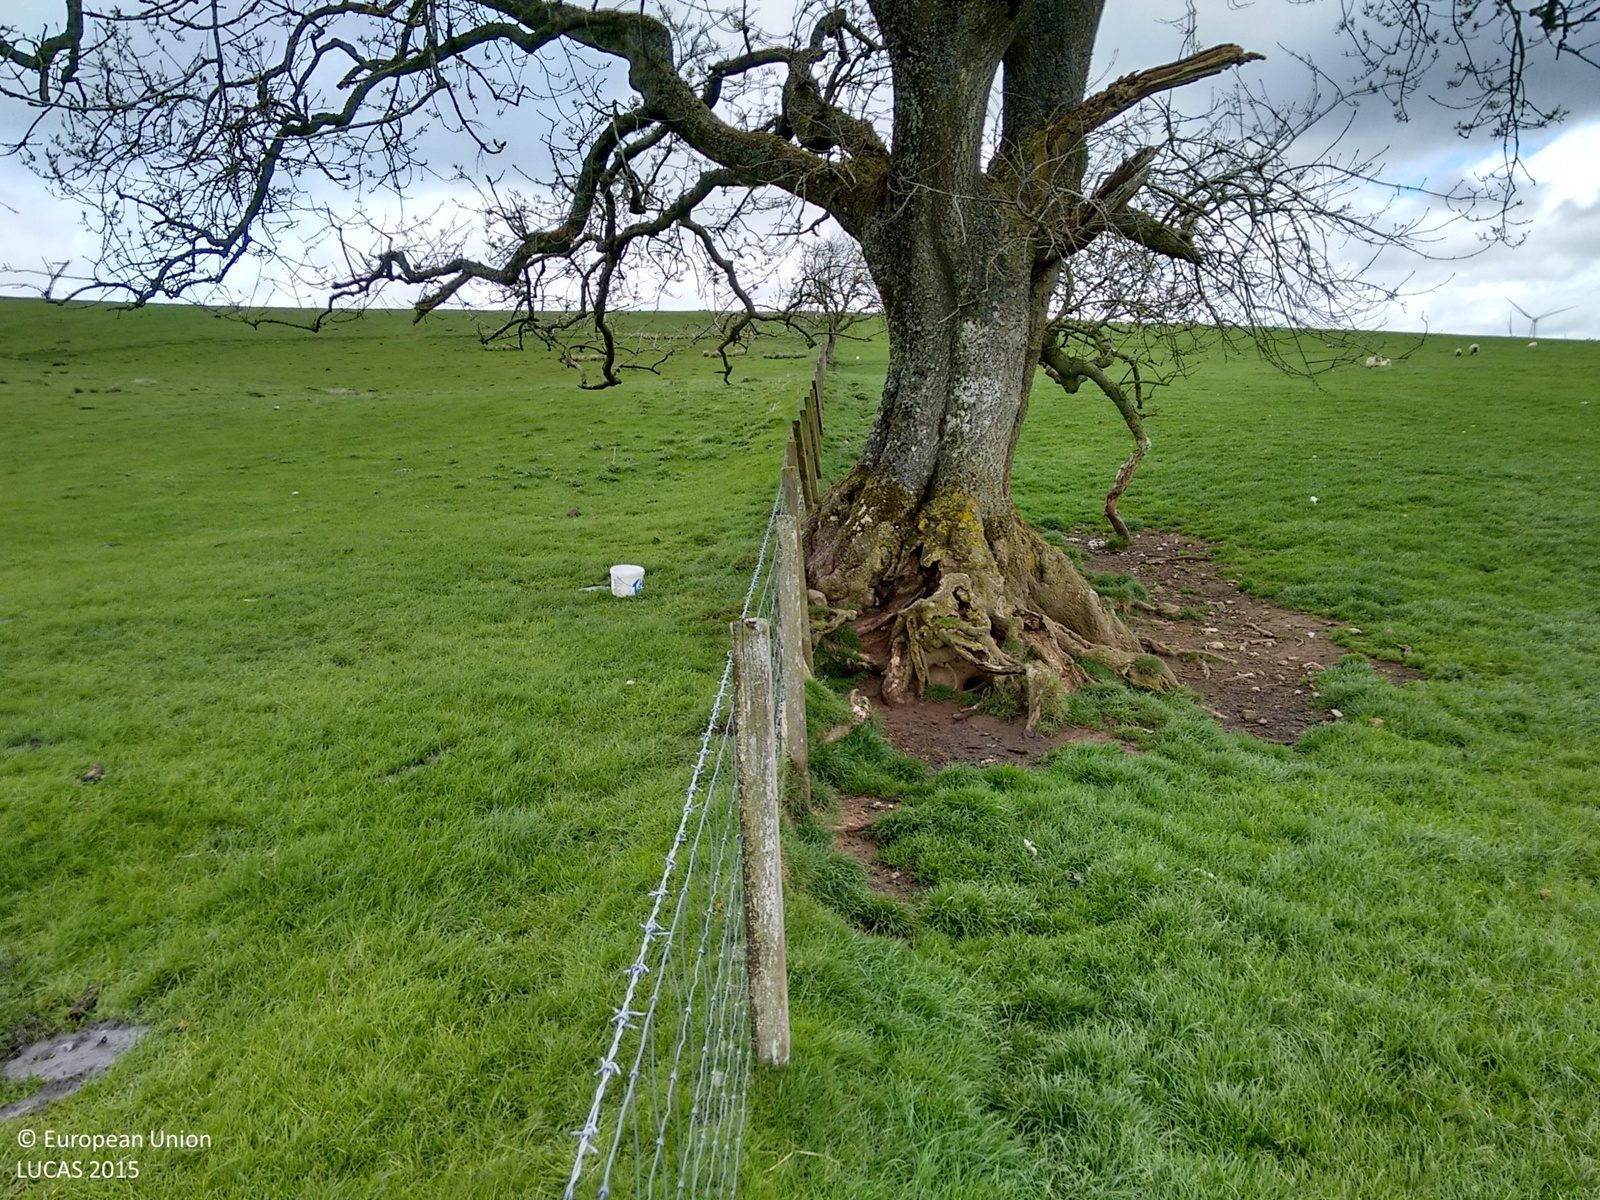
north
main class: Grassland
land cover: Grassland without tree/shrub cover
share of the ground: > 75 %
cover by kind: herbaceous plants 100 %
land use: Agriculture (excluding fallow land and kitchen gardens)
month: May
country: GB
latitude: 55.1168
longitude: -2.1447
